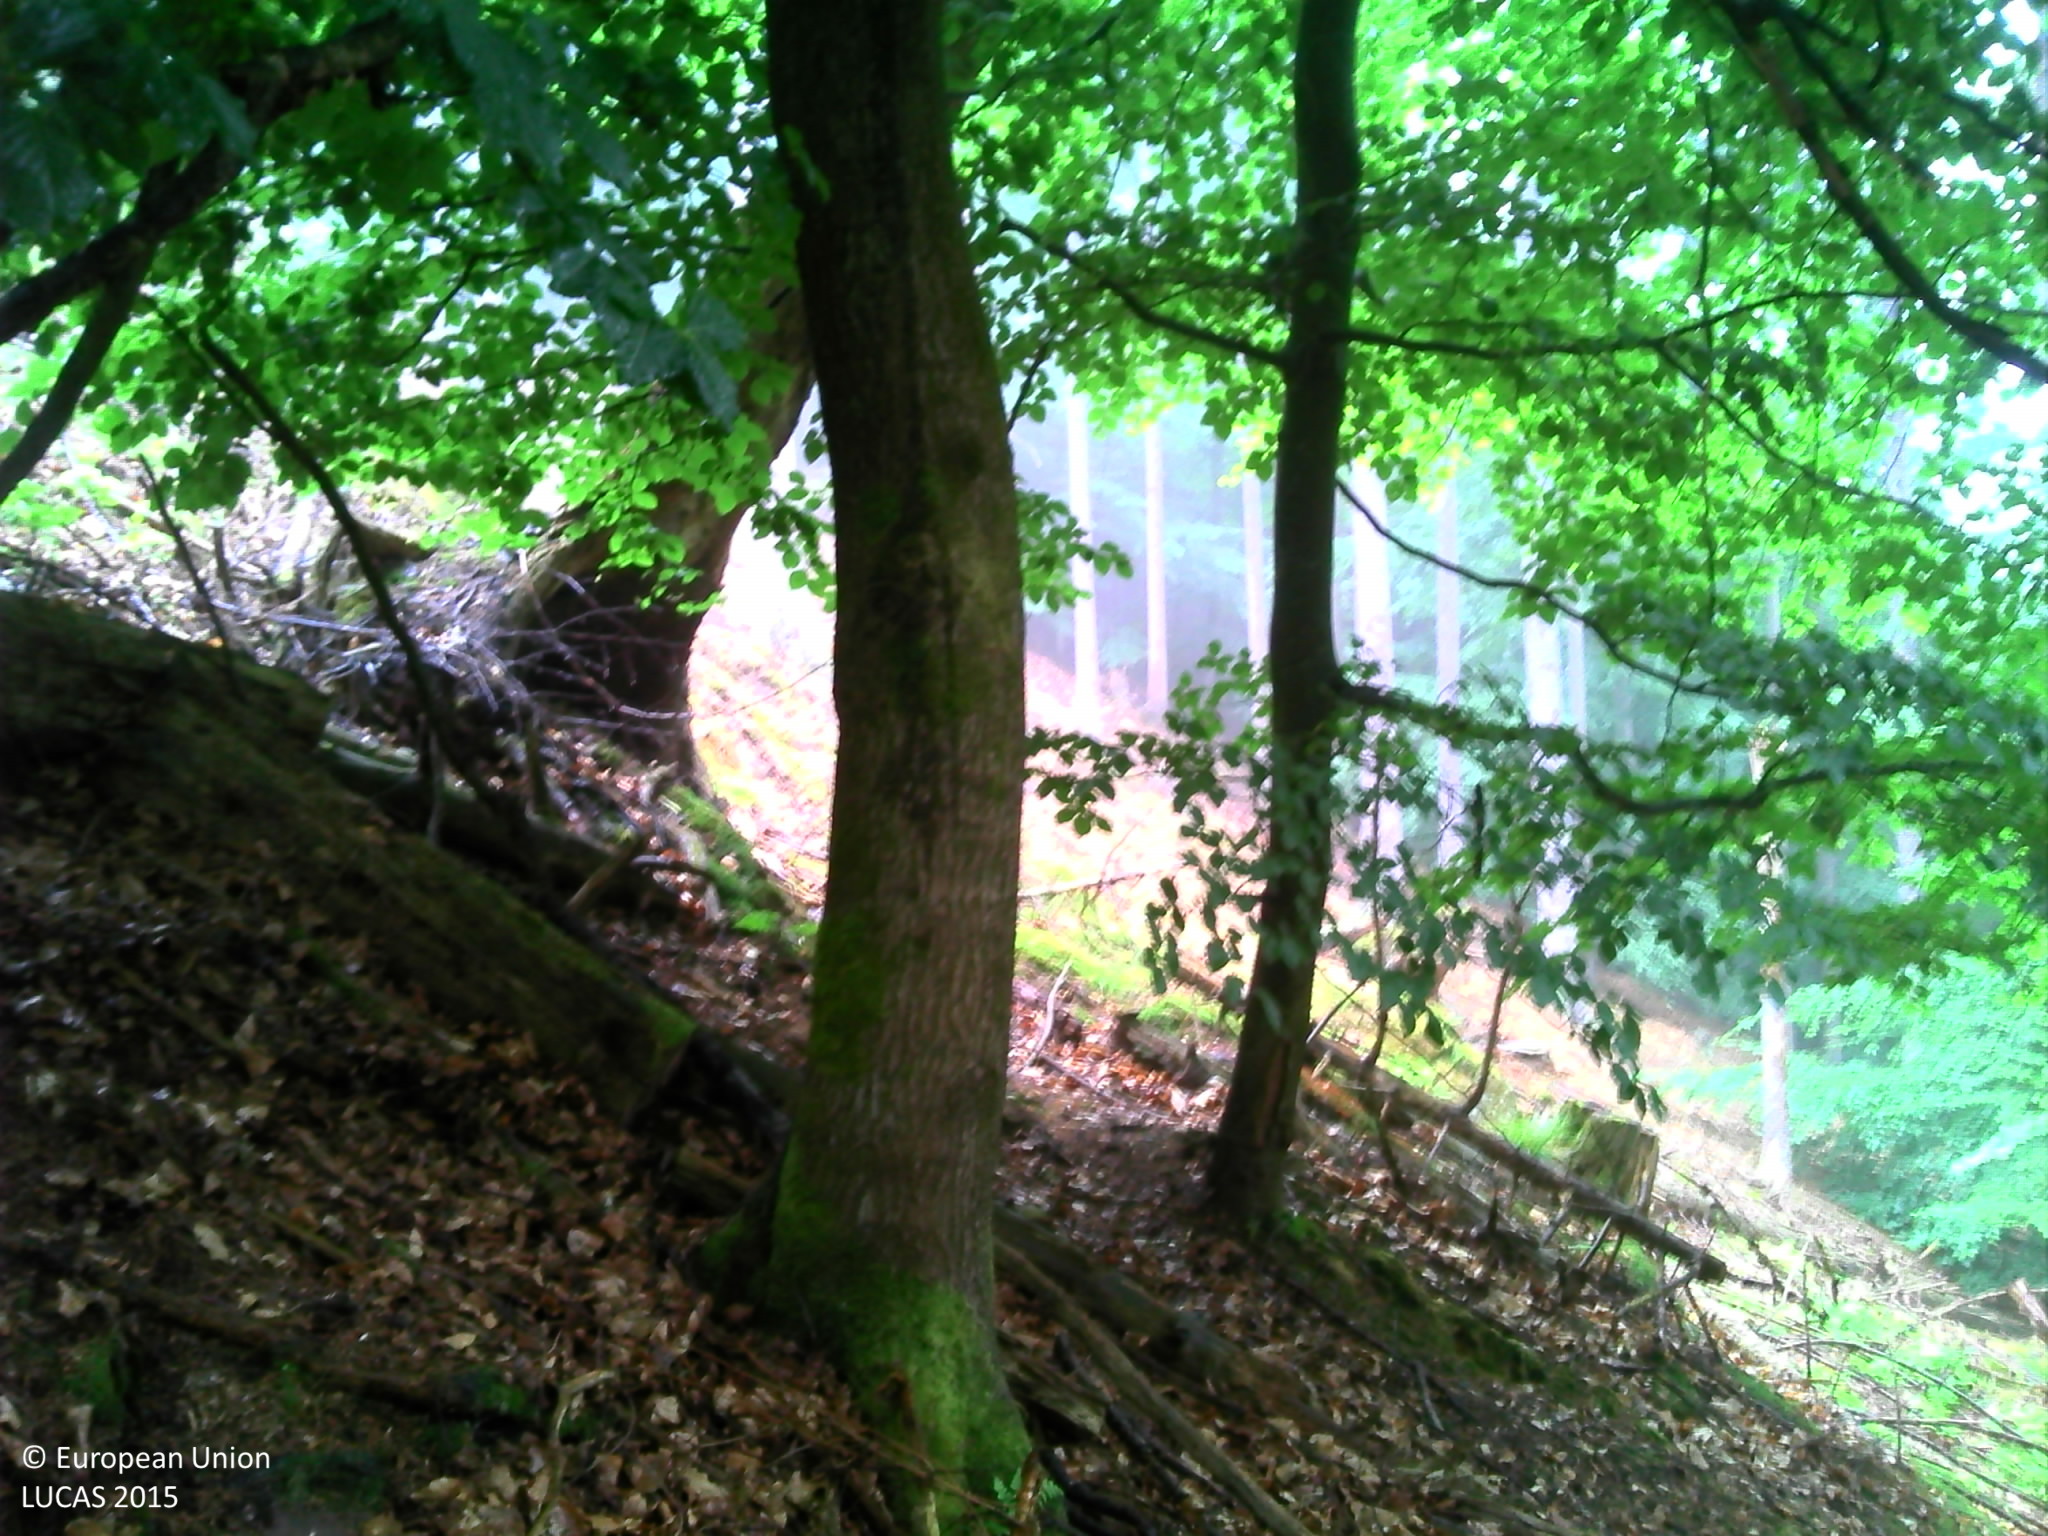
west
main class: Woodland
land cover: Spruce dominated mixed woodland
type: beech forest
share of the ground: > 75 %
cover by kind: coniferous forest trees 65 %, broadleaved forest trees 25 %, shrubs 5 %, herbaceous plants 5 %
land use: Forestry
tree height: > 5 m
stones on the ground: < 10 %
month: June
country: FR
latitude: 48.9919
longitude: 7.7183
